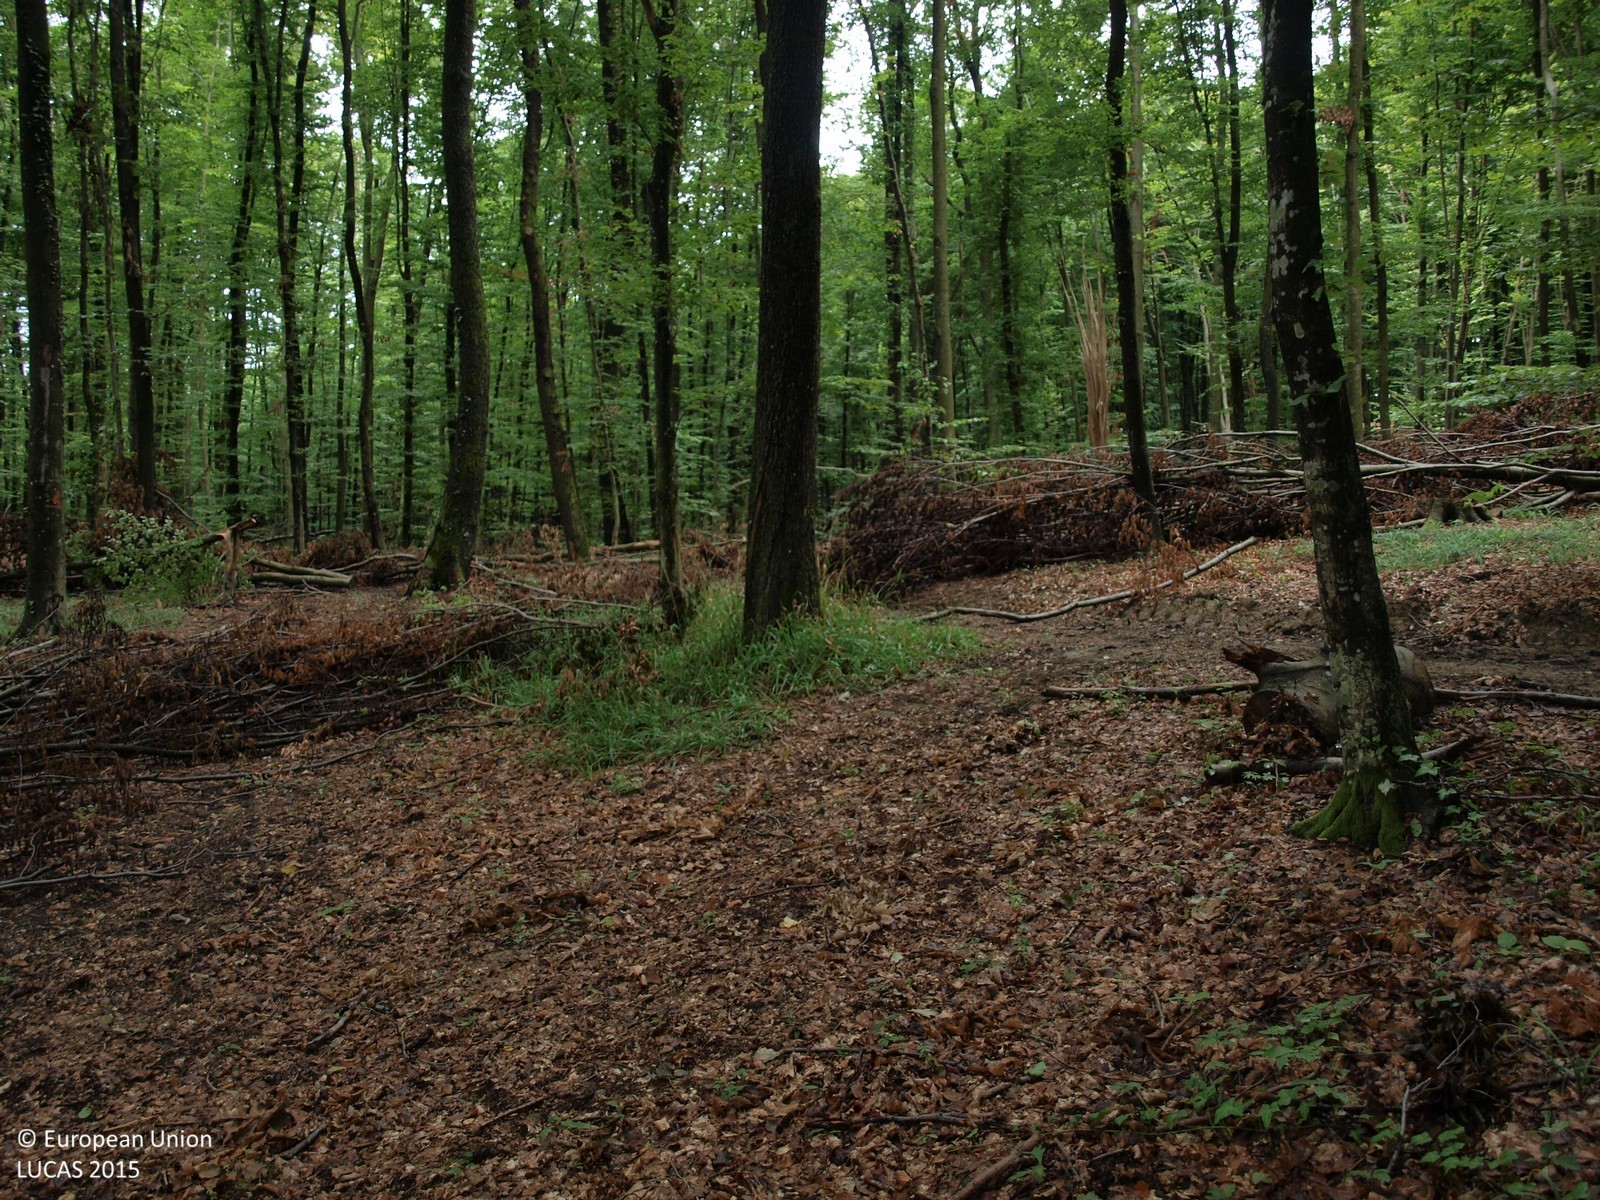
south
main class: Woodland
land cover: Broadleaved woodland
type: beech forest
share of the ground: > 75 %
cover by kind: broadleaved forest trees 100 %
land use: Forestry
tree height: > 5 m
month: July
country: HR
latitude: 46.0559
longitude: 16.3199
